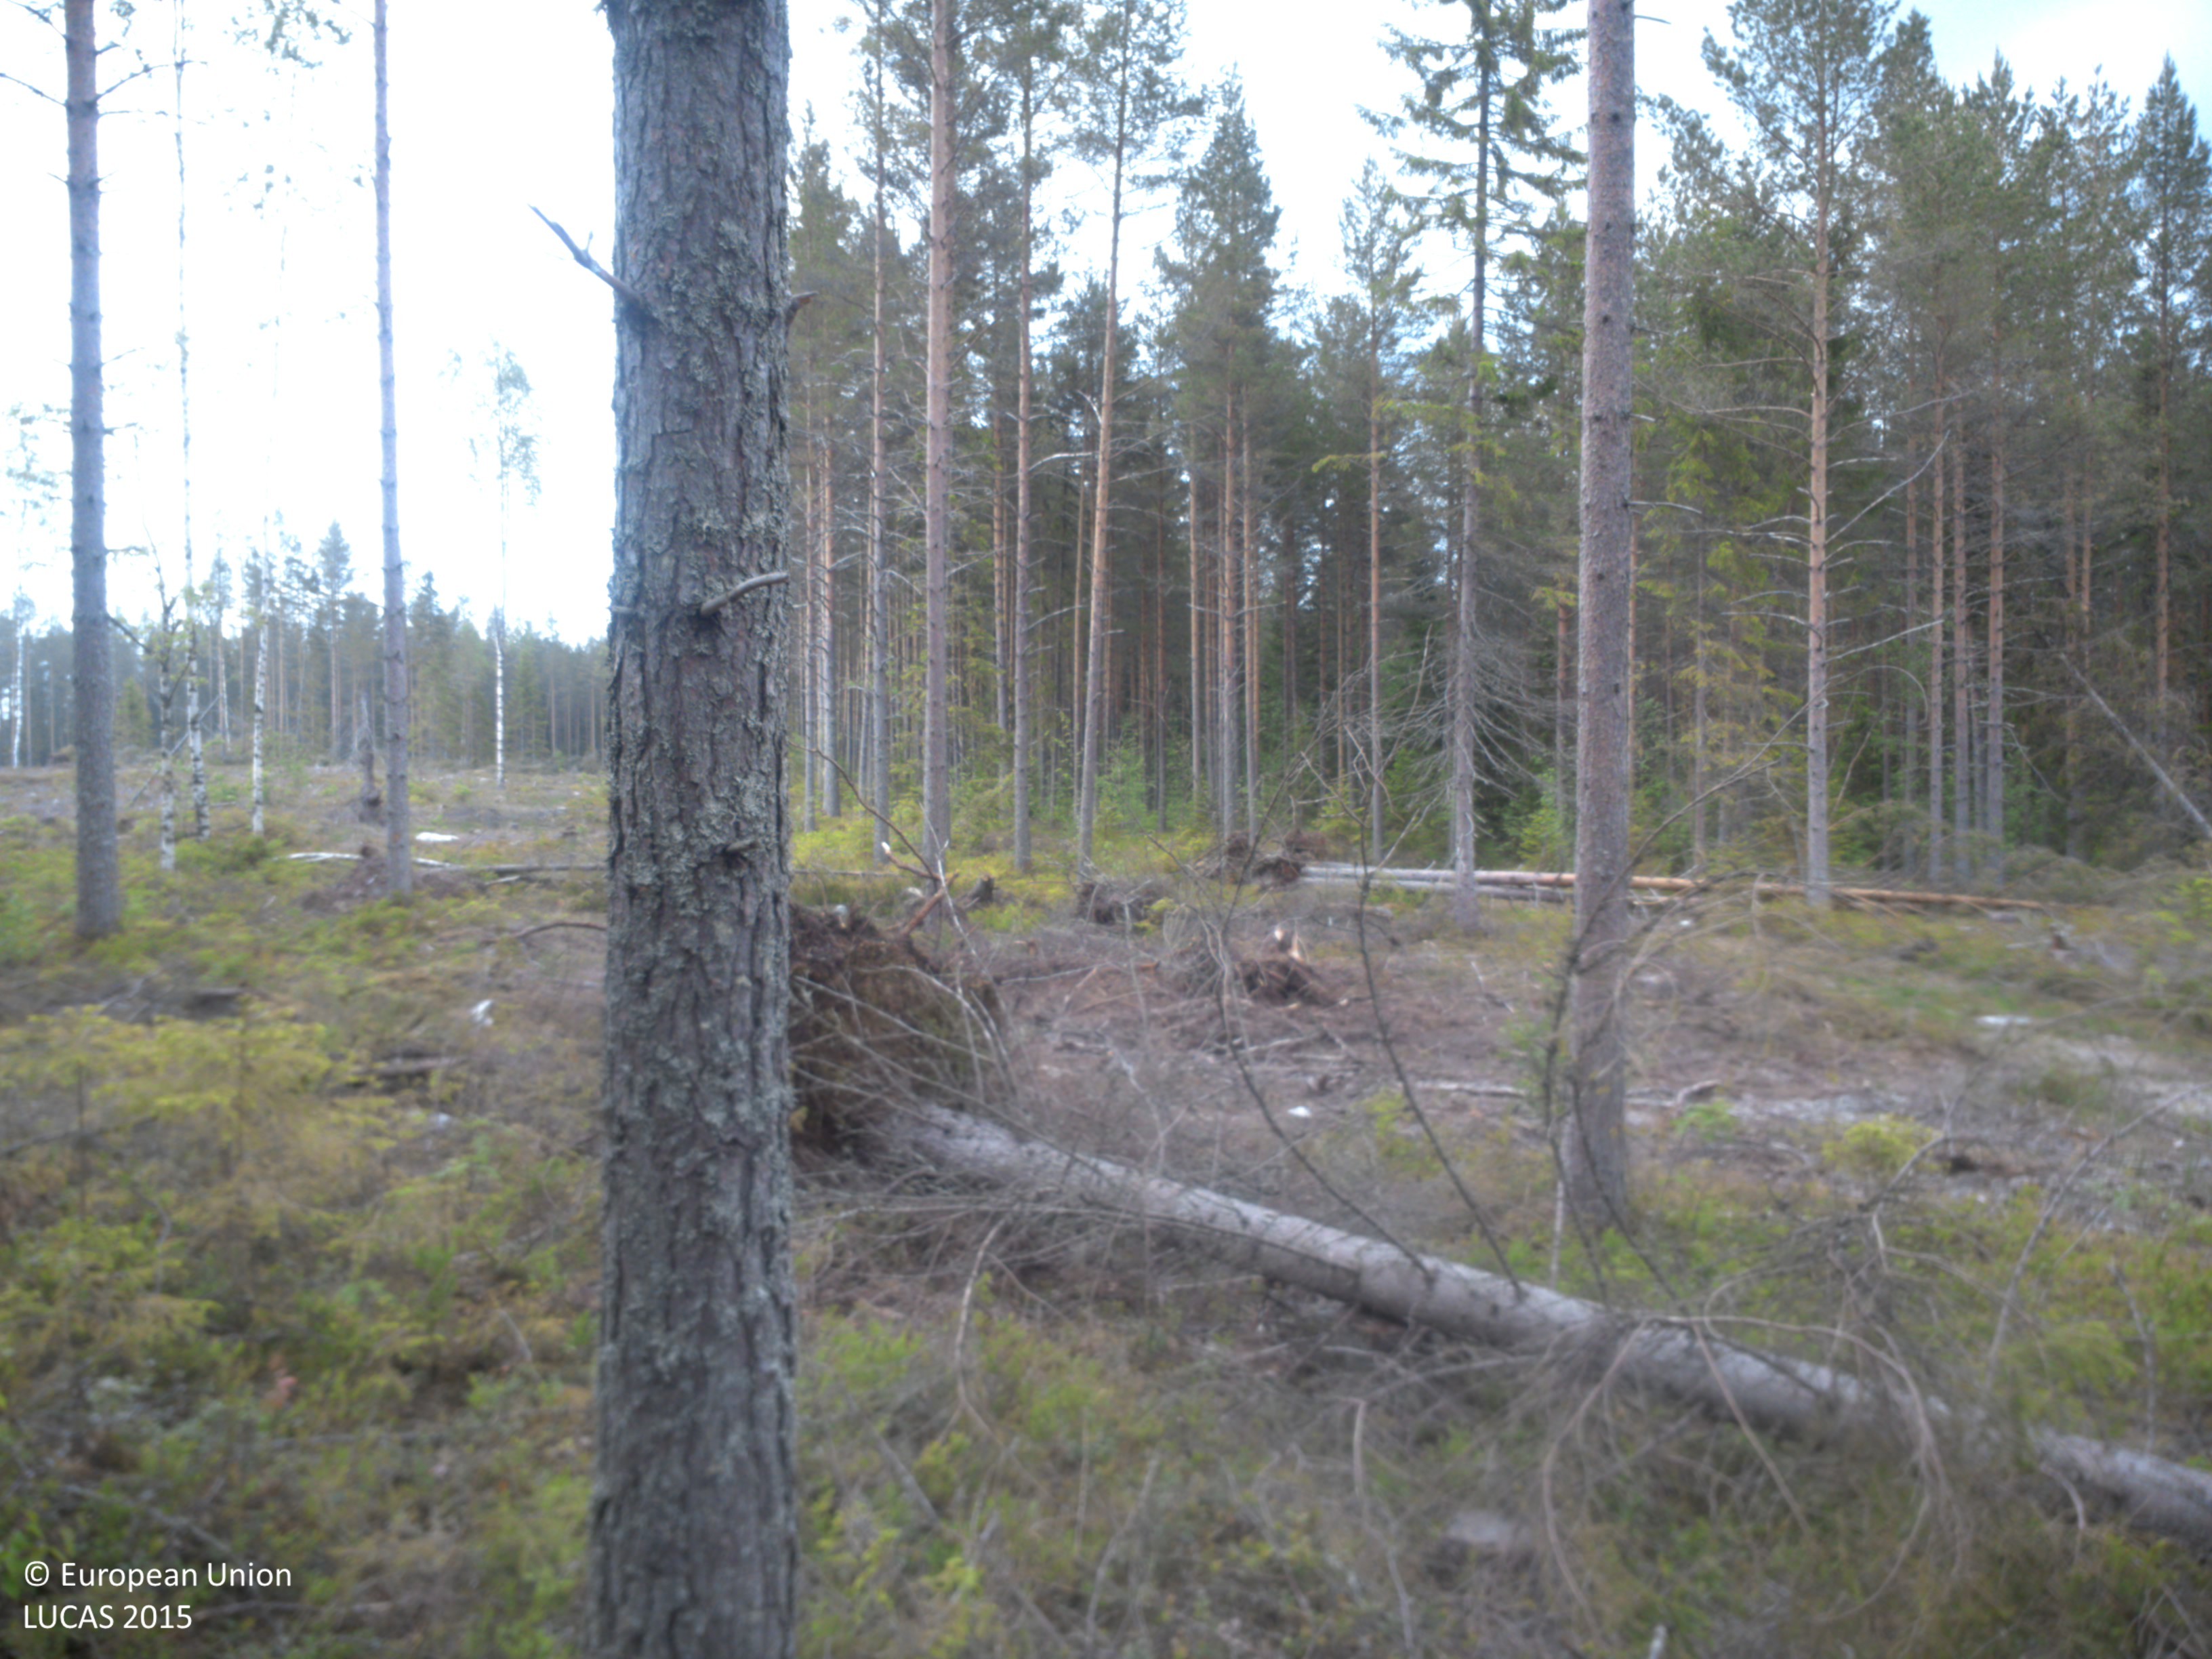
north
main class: Woodland
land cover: Pine dominated coniferous woodland
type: boreal forest
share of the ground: 25 - 50 %
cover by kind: herbaceous plants 30 %, coniferous forest trees 25 %, shrubs 20 %, lichens and mosses 15 %, unconsolidated bare surface 10 %
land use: Forestry
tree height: > 5 m
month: June
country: SE
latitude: 63.5824
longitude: 19.8326
